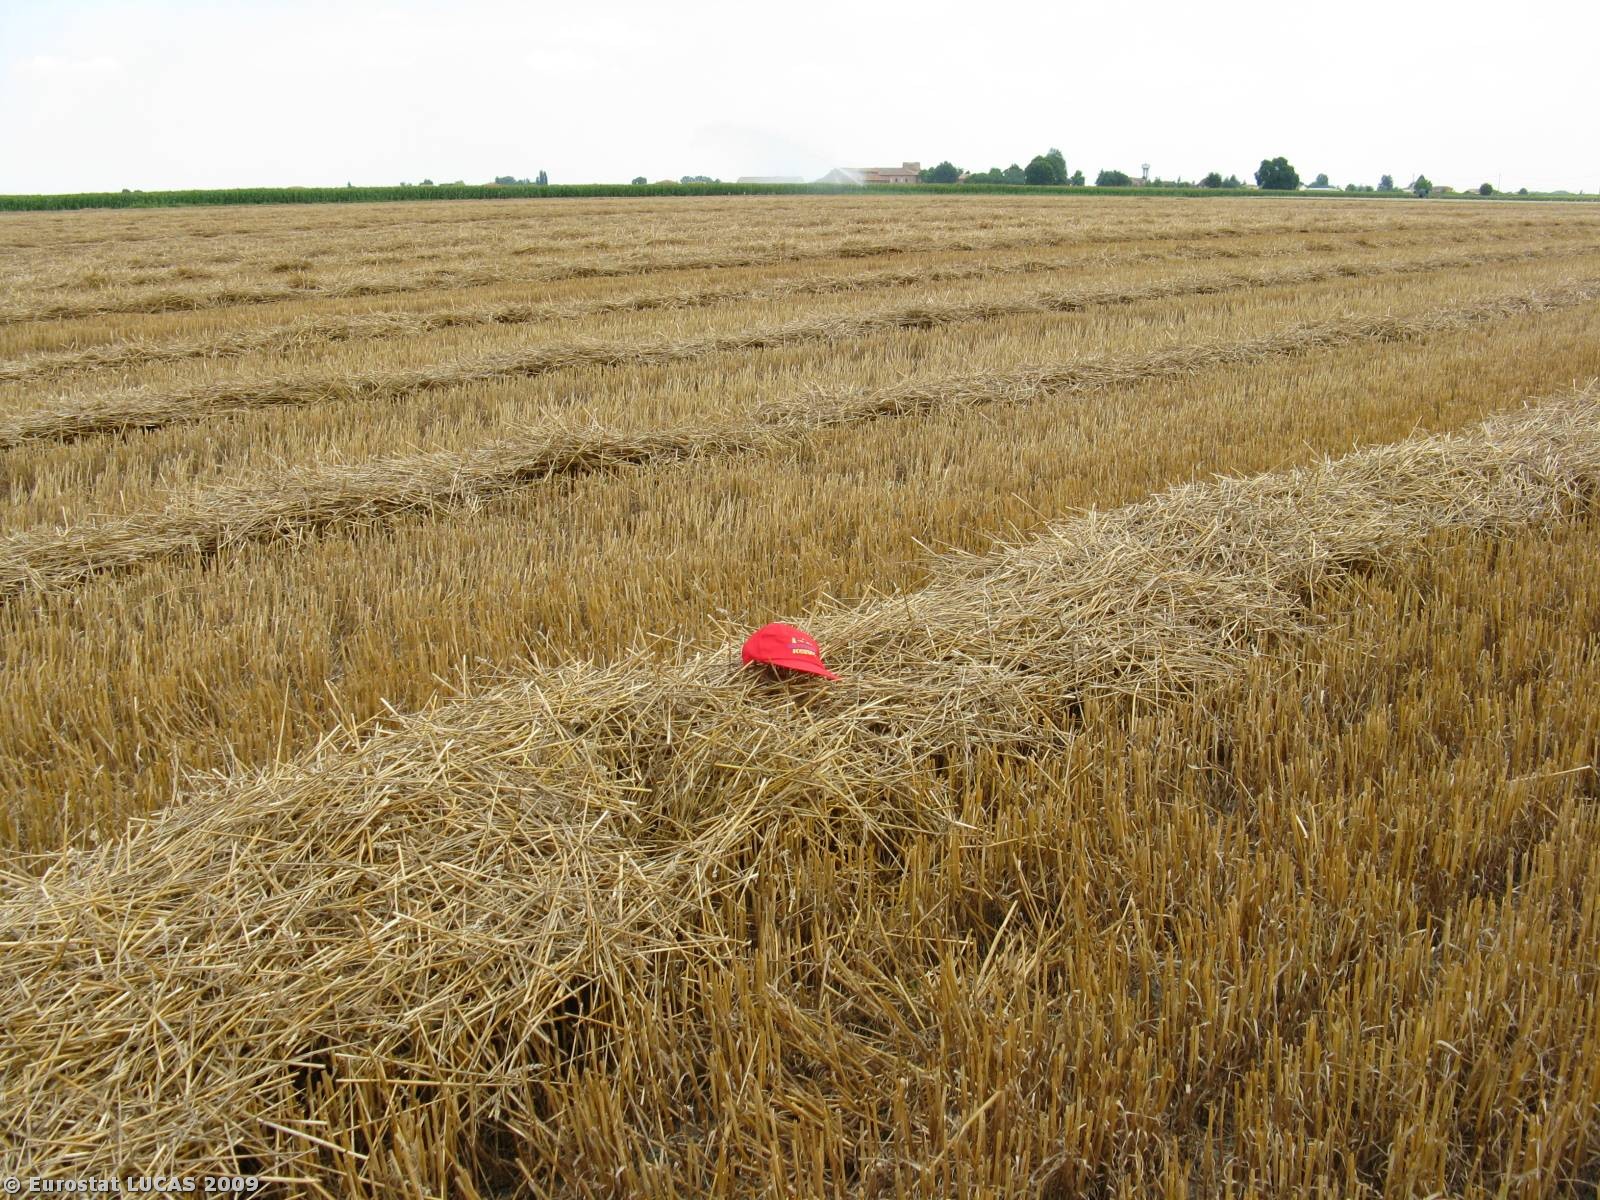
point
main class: Cropland
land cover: Common wheat
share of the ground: < 10 %
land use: Agriculture (excluding fallow land and kitchen gardens)
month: June
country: IT
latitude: 44.6790
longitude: 11.7248
